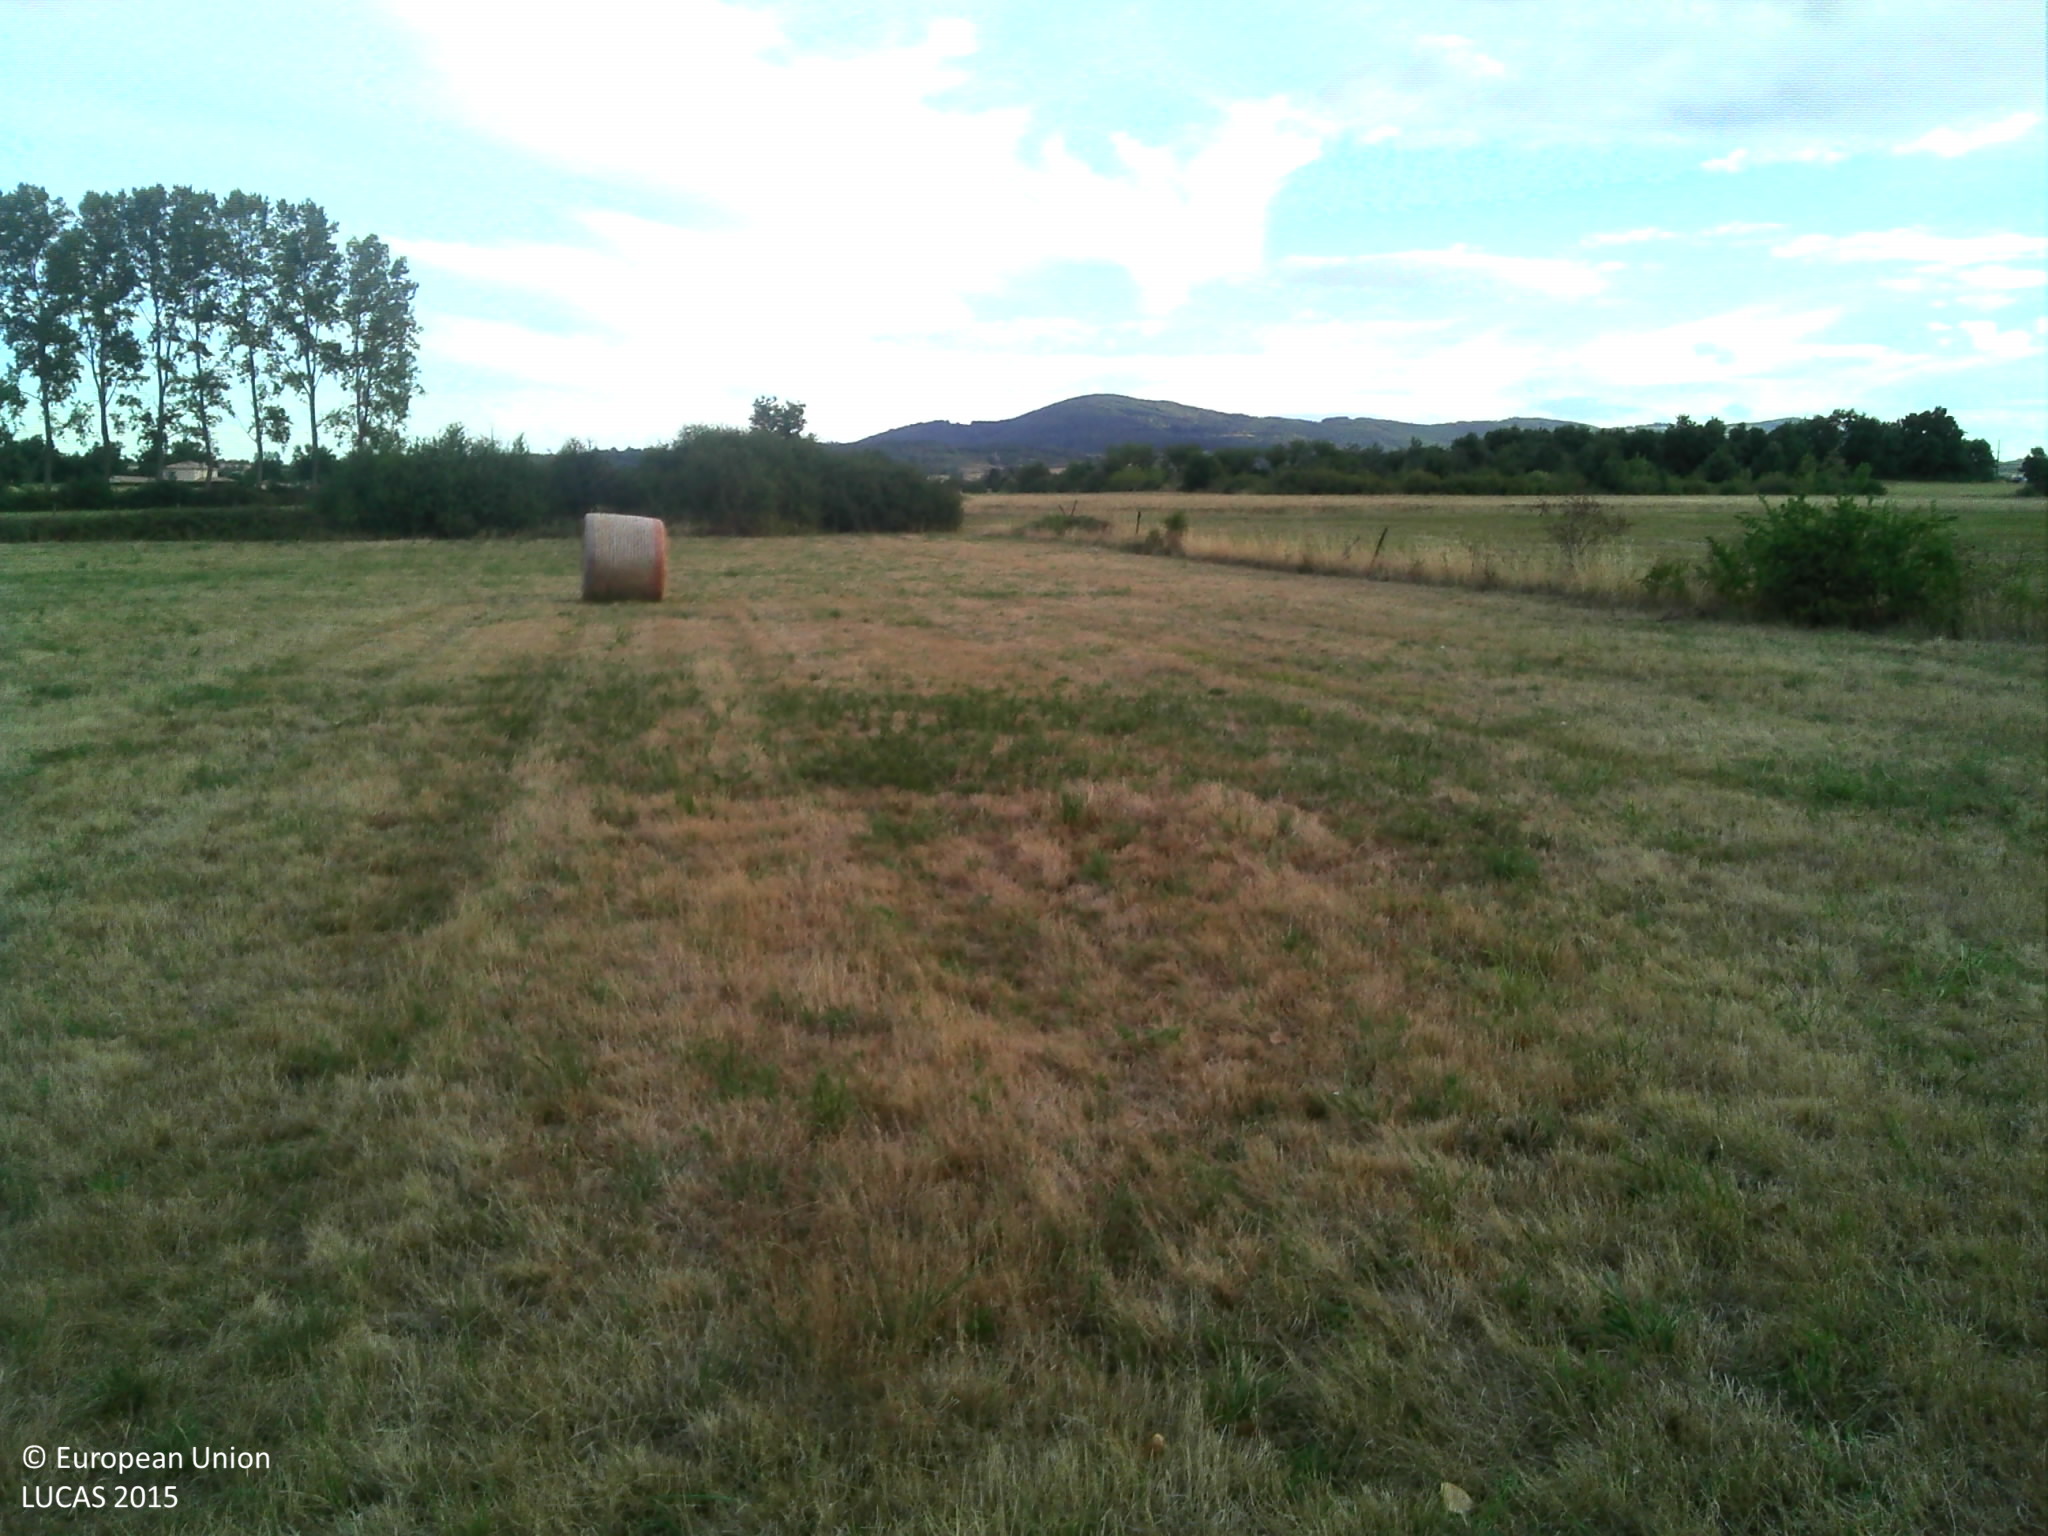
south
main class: Grassland
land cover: Grassland without tree/shrub cover
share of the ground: > 75 %
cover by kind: herbaceous plants 100 %
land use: Agriculture (excluding fallow land and kitchen gardens)
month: August
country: FR
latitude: 45.1726
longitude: 4.6990
